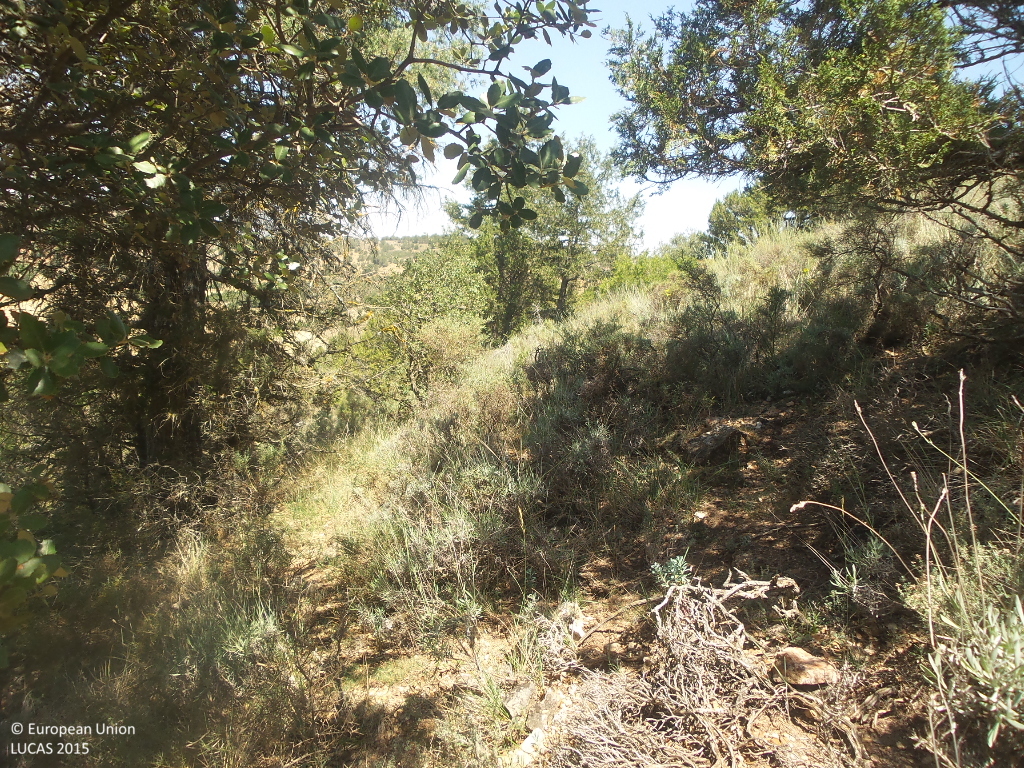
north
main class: Woodland
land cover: Other mixed woodland
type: coniferous forest of the mediterranean region
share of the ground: 25 - 50 %
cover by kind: unconsolidated bare surface 40 %, shrubs 25 %, coniferous forest trees 20 %, broadleaved forest trees 10 %, herbaceous plants 5 %
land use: Semi-natural and natural areas not in use
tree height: > 5 m
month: July
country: ES
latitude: 41.1329
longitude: -2.1668
